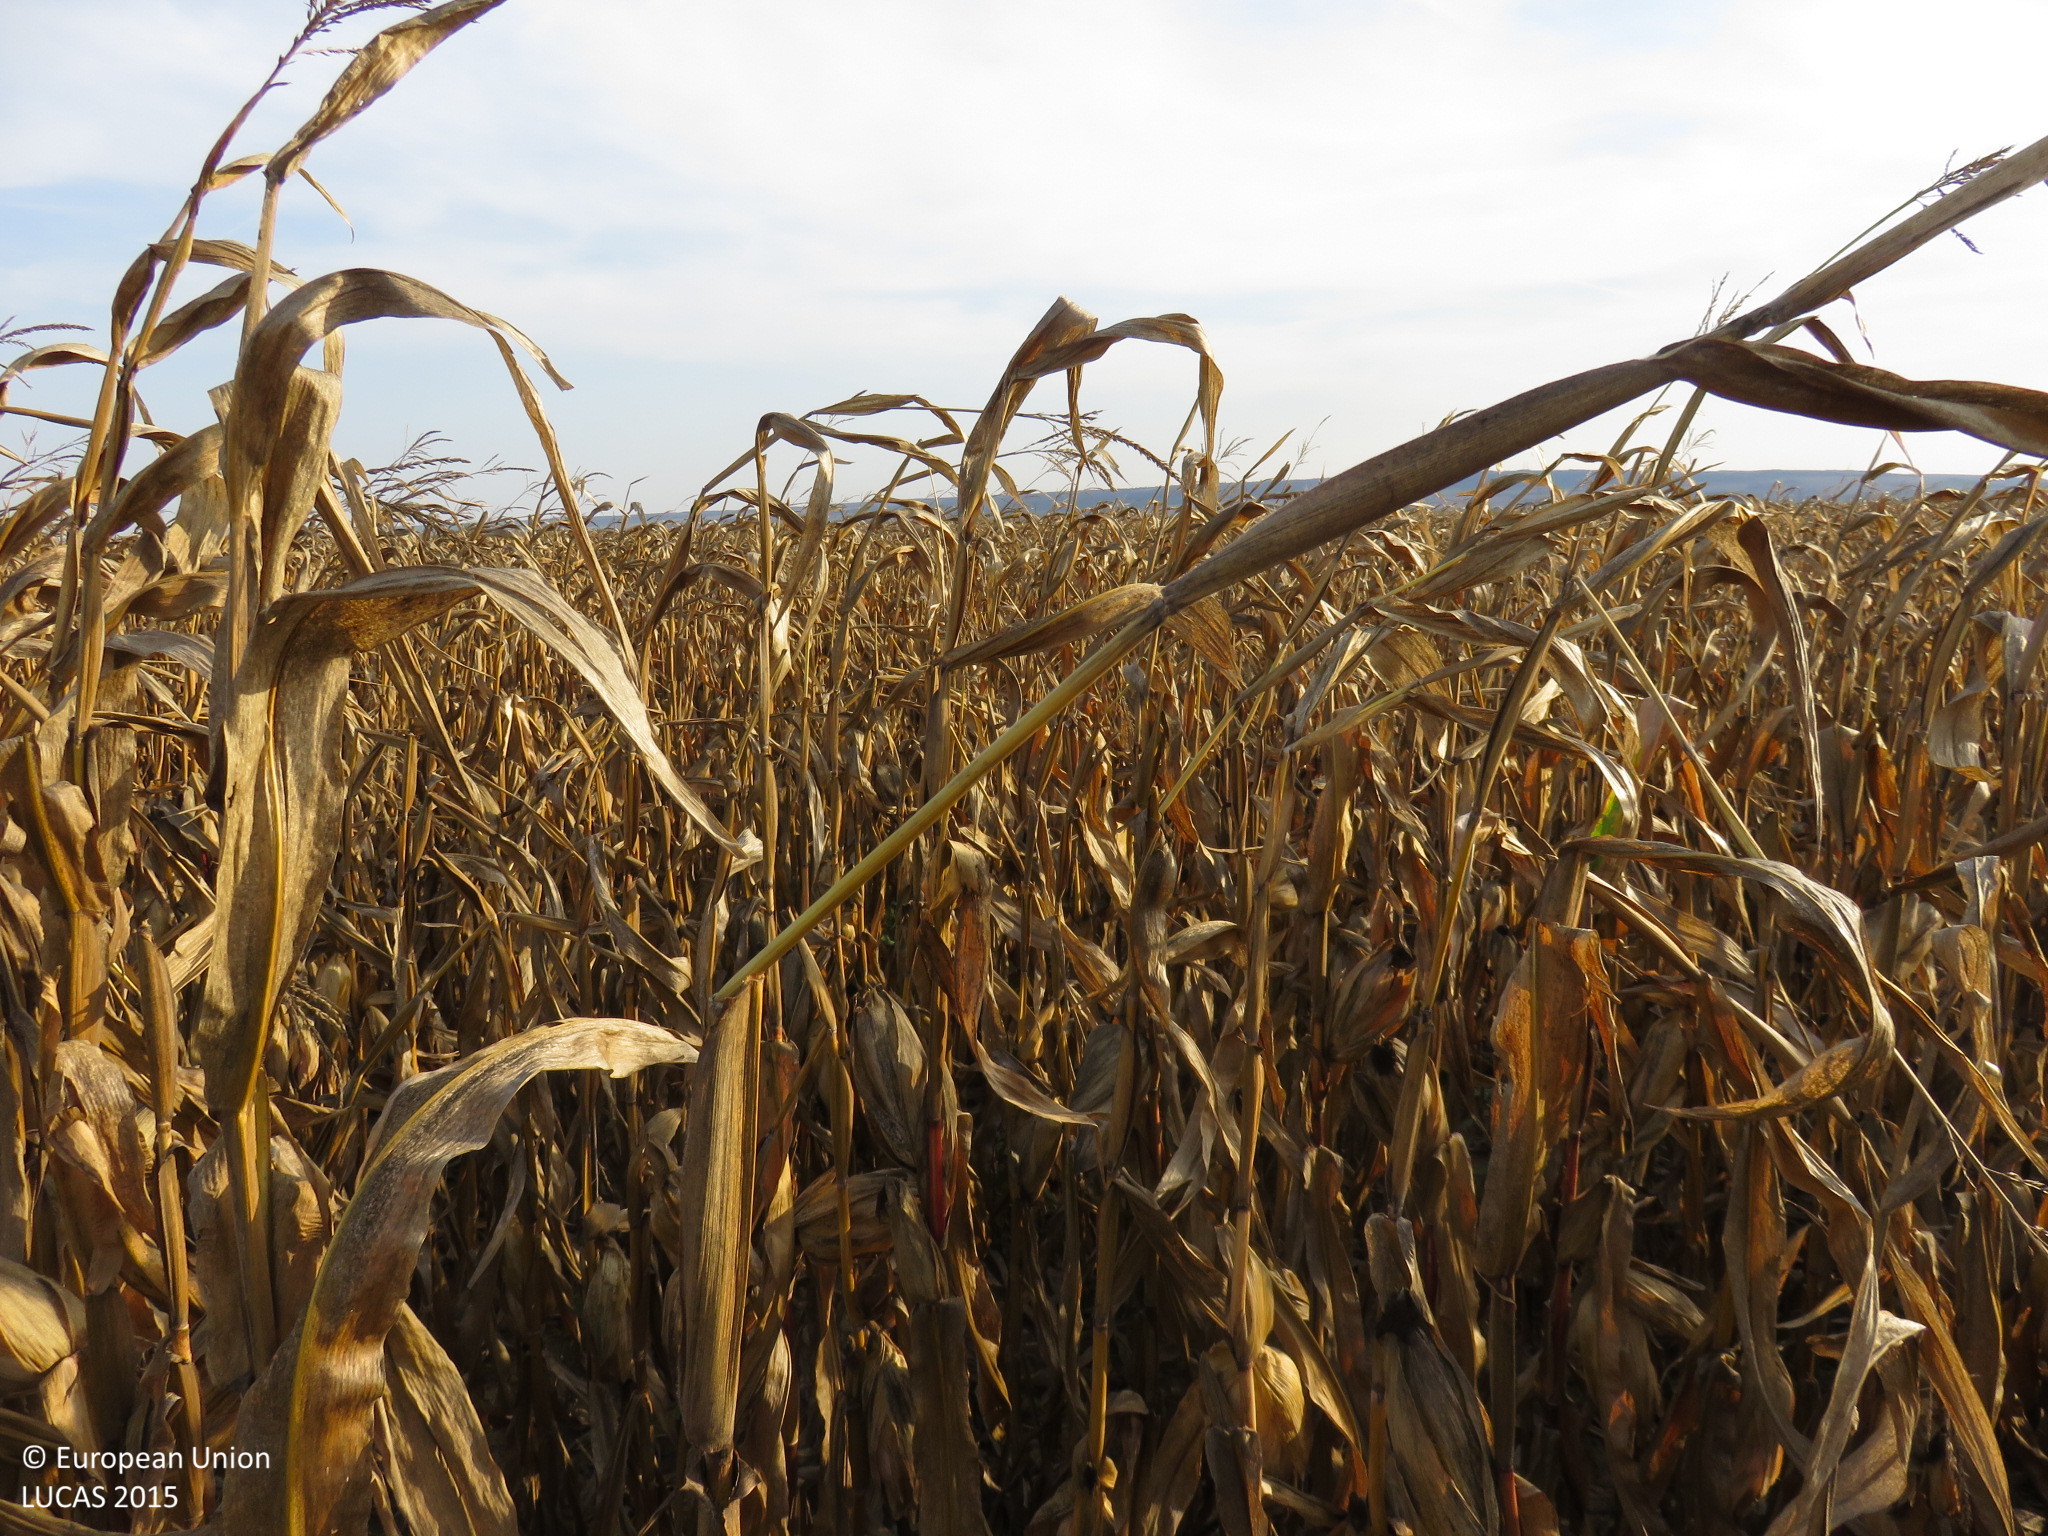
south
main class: Cropland
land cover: Maize
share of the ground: > 75 %
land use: Agriculture (excluding fallow land and kitchen gardens)
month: September
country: BG
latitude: 43.7282
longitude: 24.5018
